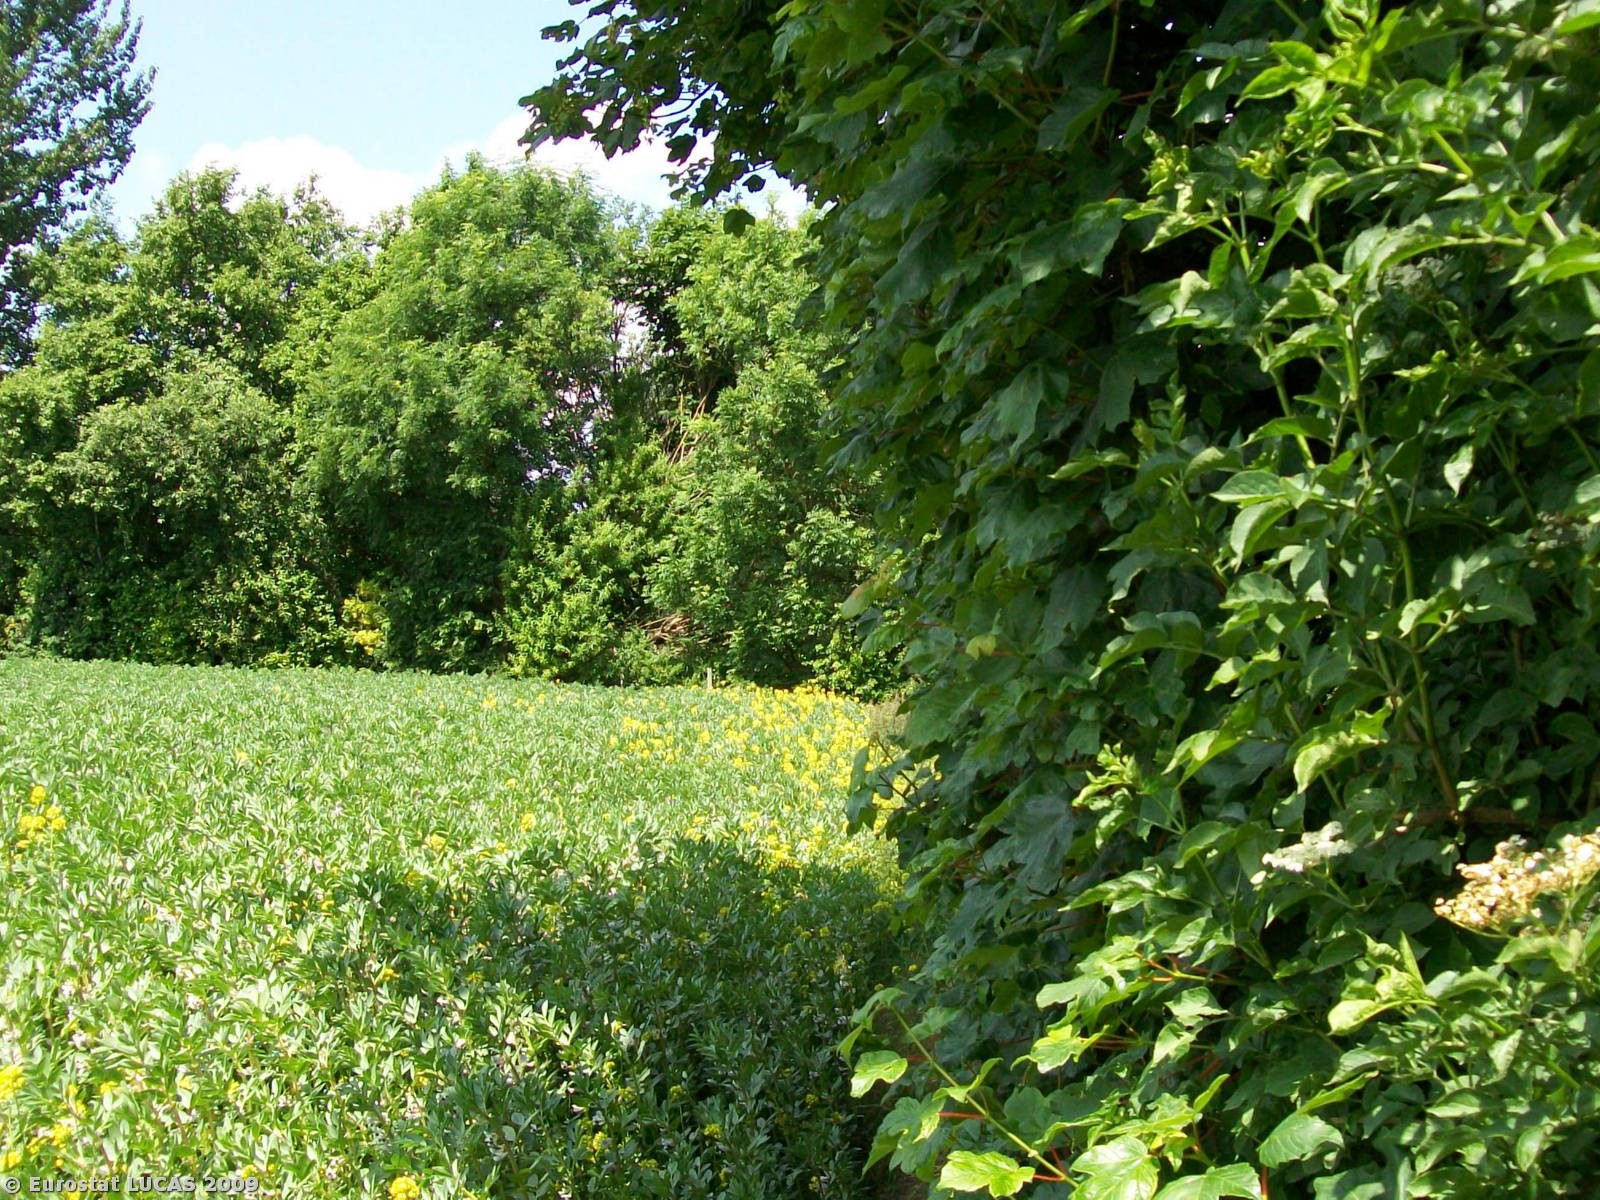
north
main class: Cropland
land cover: Dry pulses
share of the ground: > 75 %
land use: Agriculture (excluding fallow land and kitchen gardens)
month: June
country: GB
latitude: 52.1216
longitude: 0.0507
